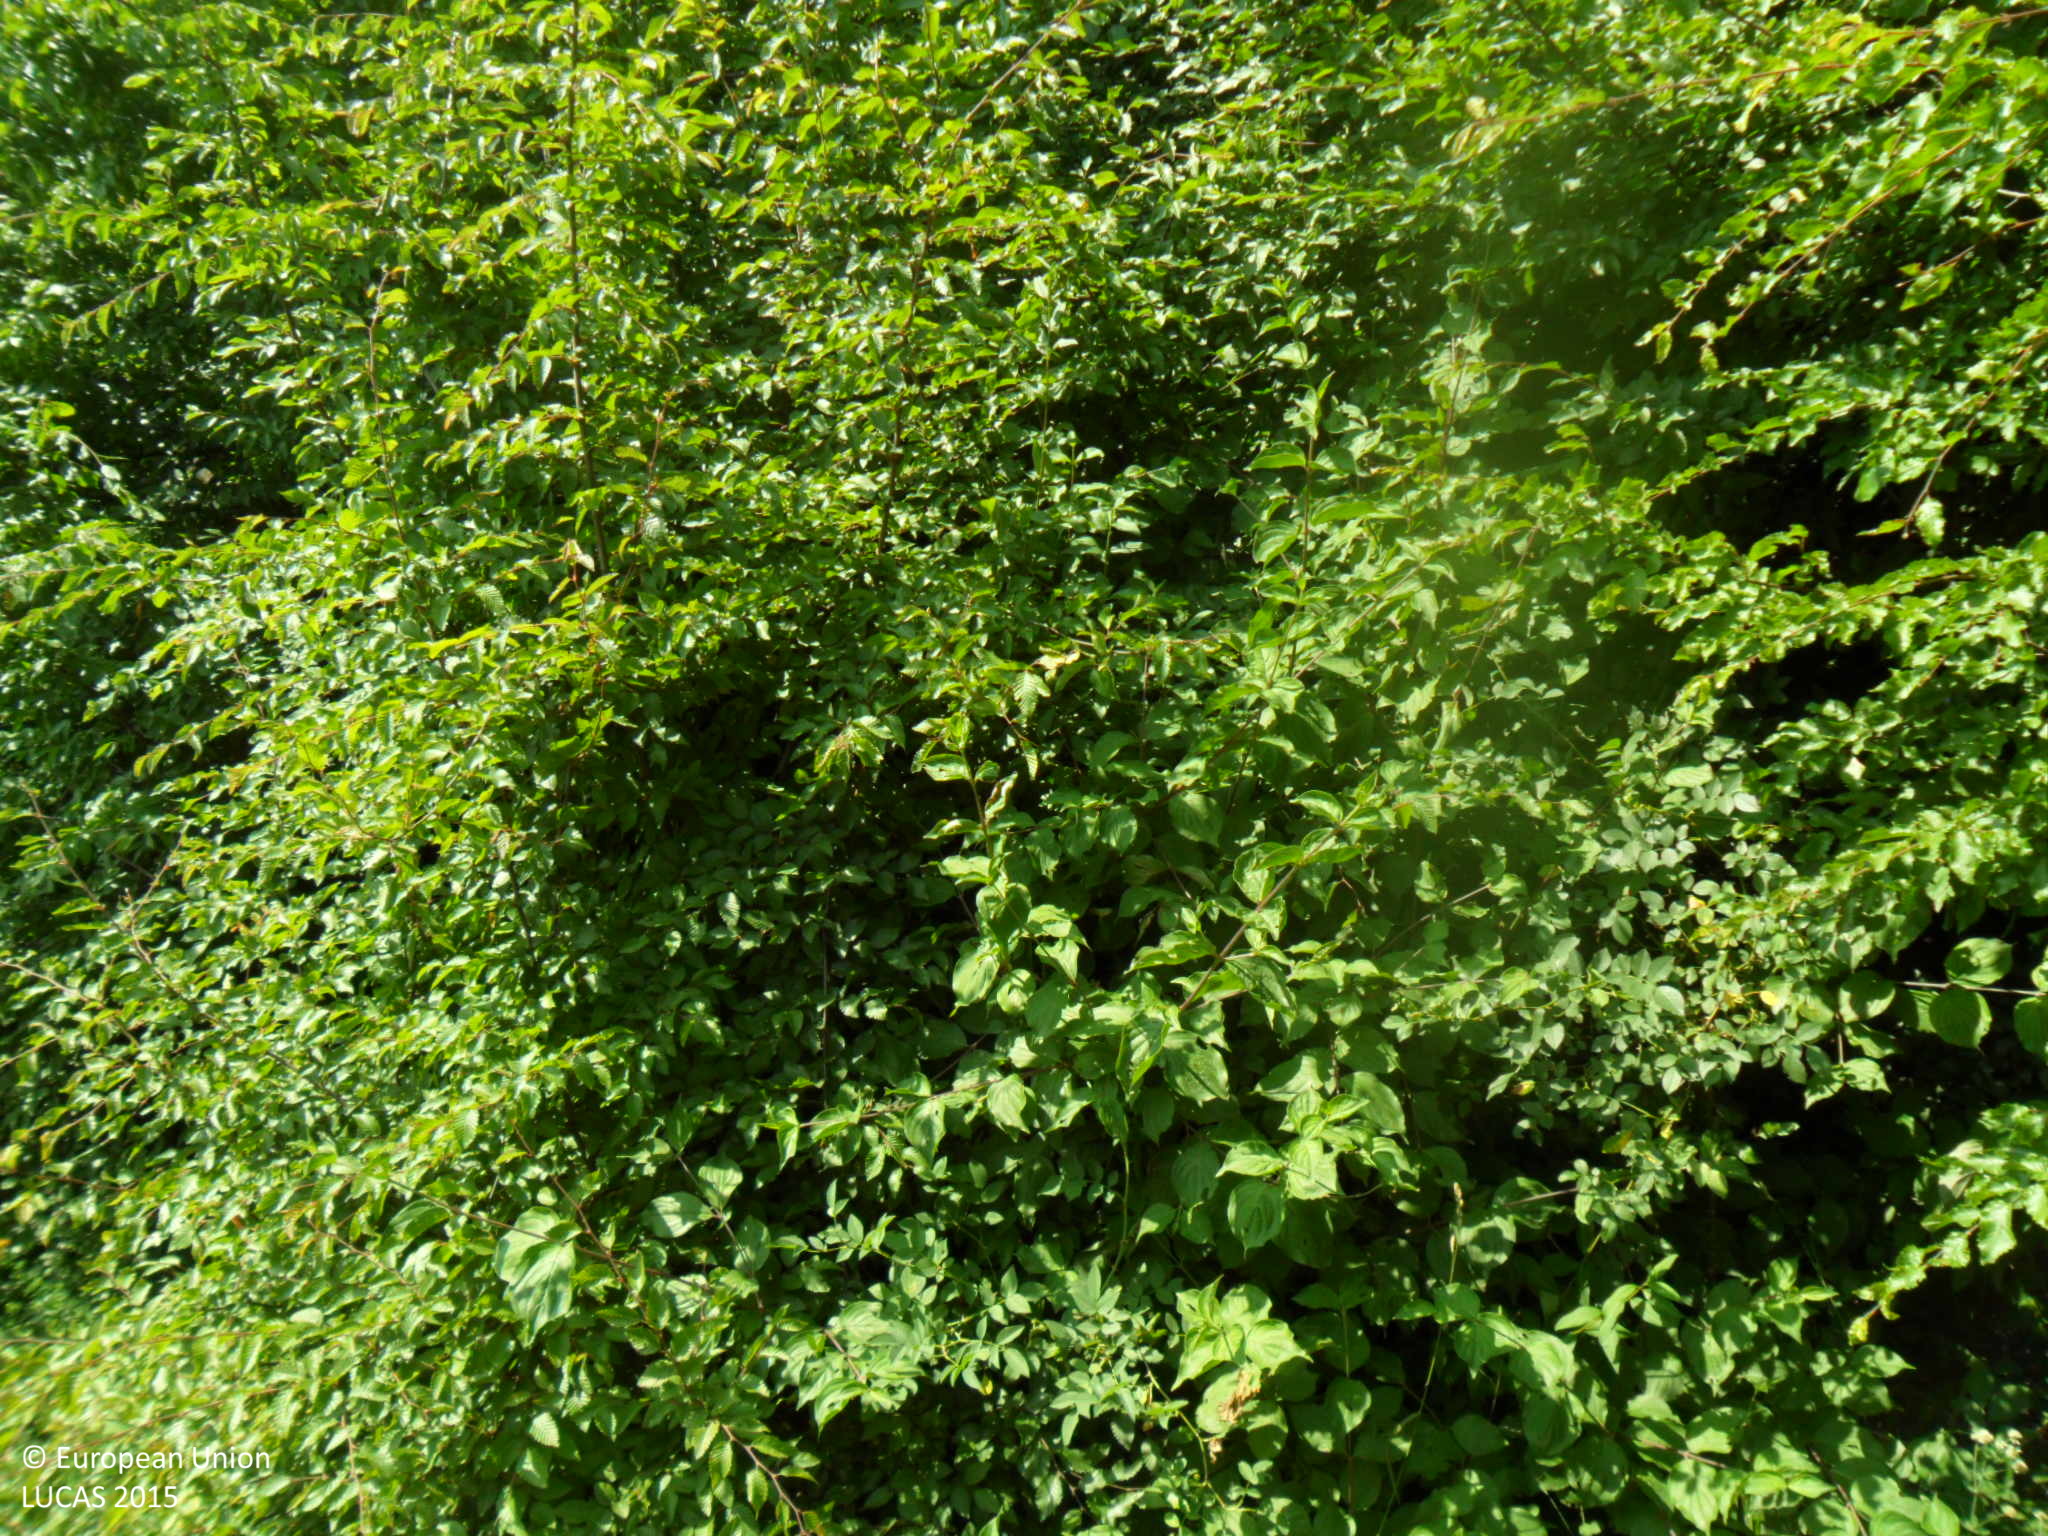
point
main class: Woodland
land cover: Broadleaved woodland
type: mesophytic deciduous forest
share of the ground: > 75 %
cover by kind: broadleaved forest trees 95 %, shrubs 5 %
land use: Forestry
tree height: > 5 m
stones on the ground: 10 - 25 %
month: June
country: BG
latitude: 43.4408
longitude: 27.0575
